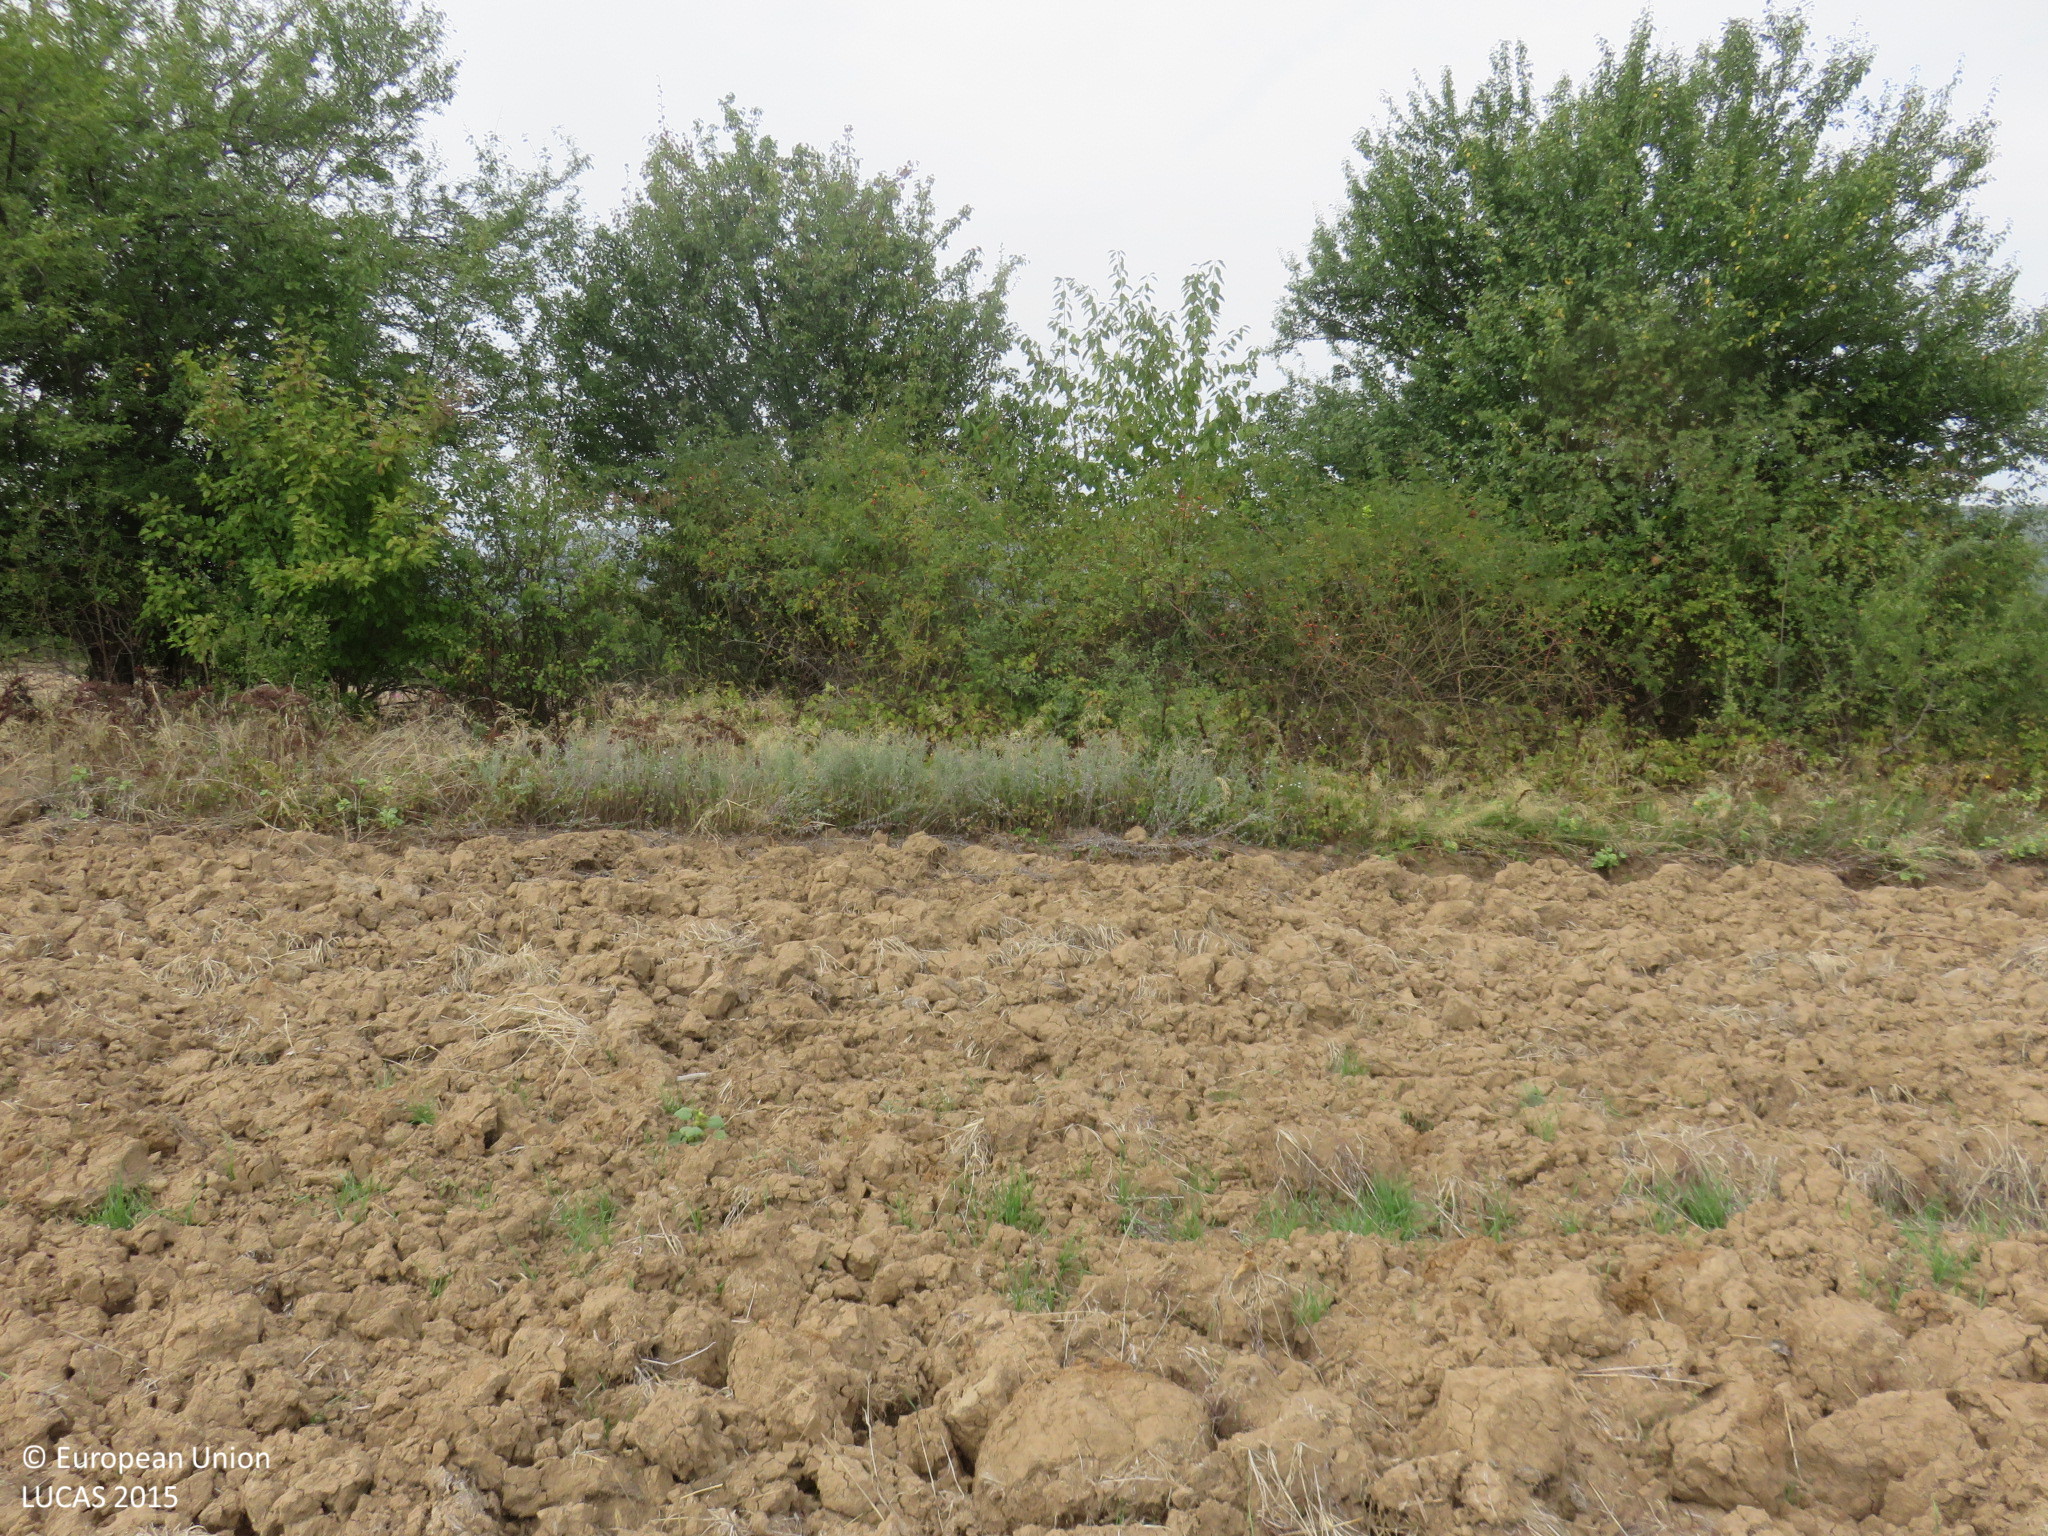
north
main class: Cropland
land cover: Common wheat
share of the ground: < 10 %
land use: Agriculture (excluding fallow land and kitchen gardens)
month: September
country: BG
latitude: 43.1635
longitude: 24.8611
